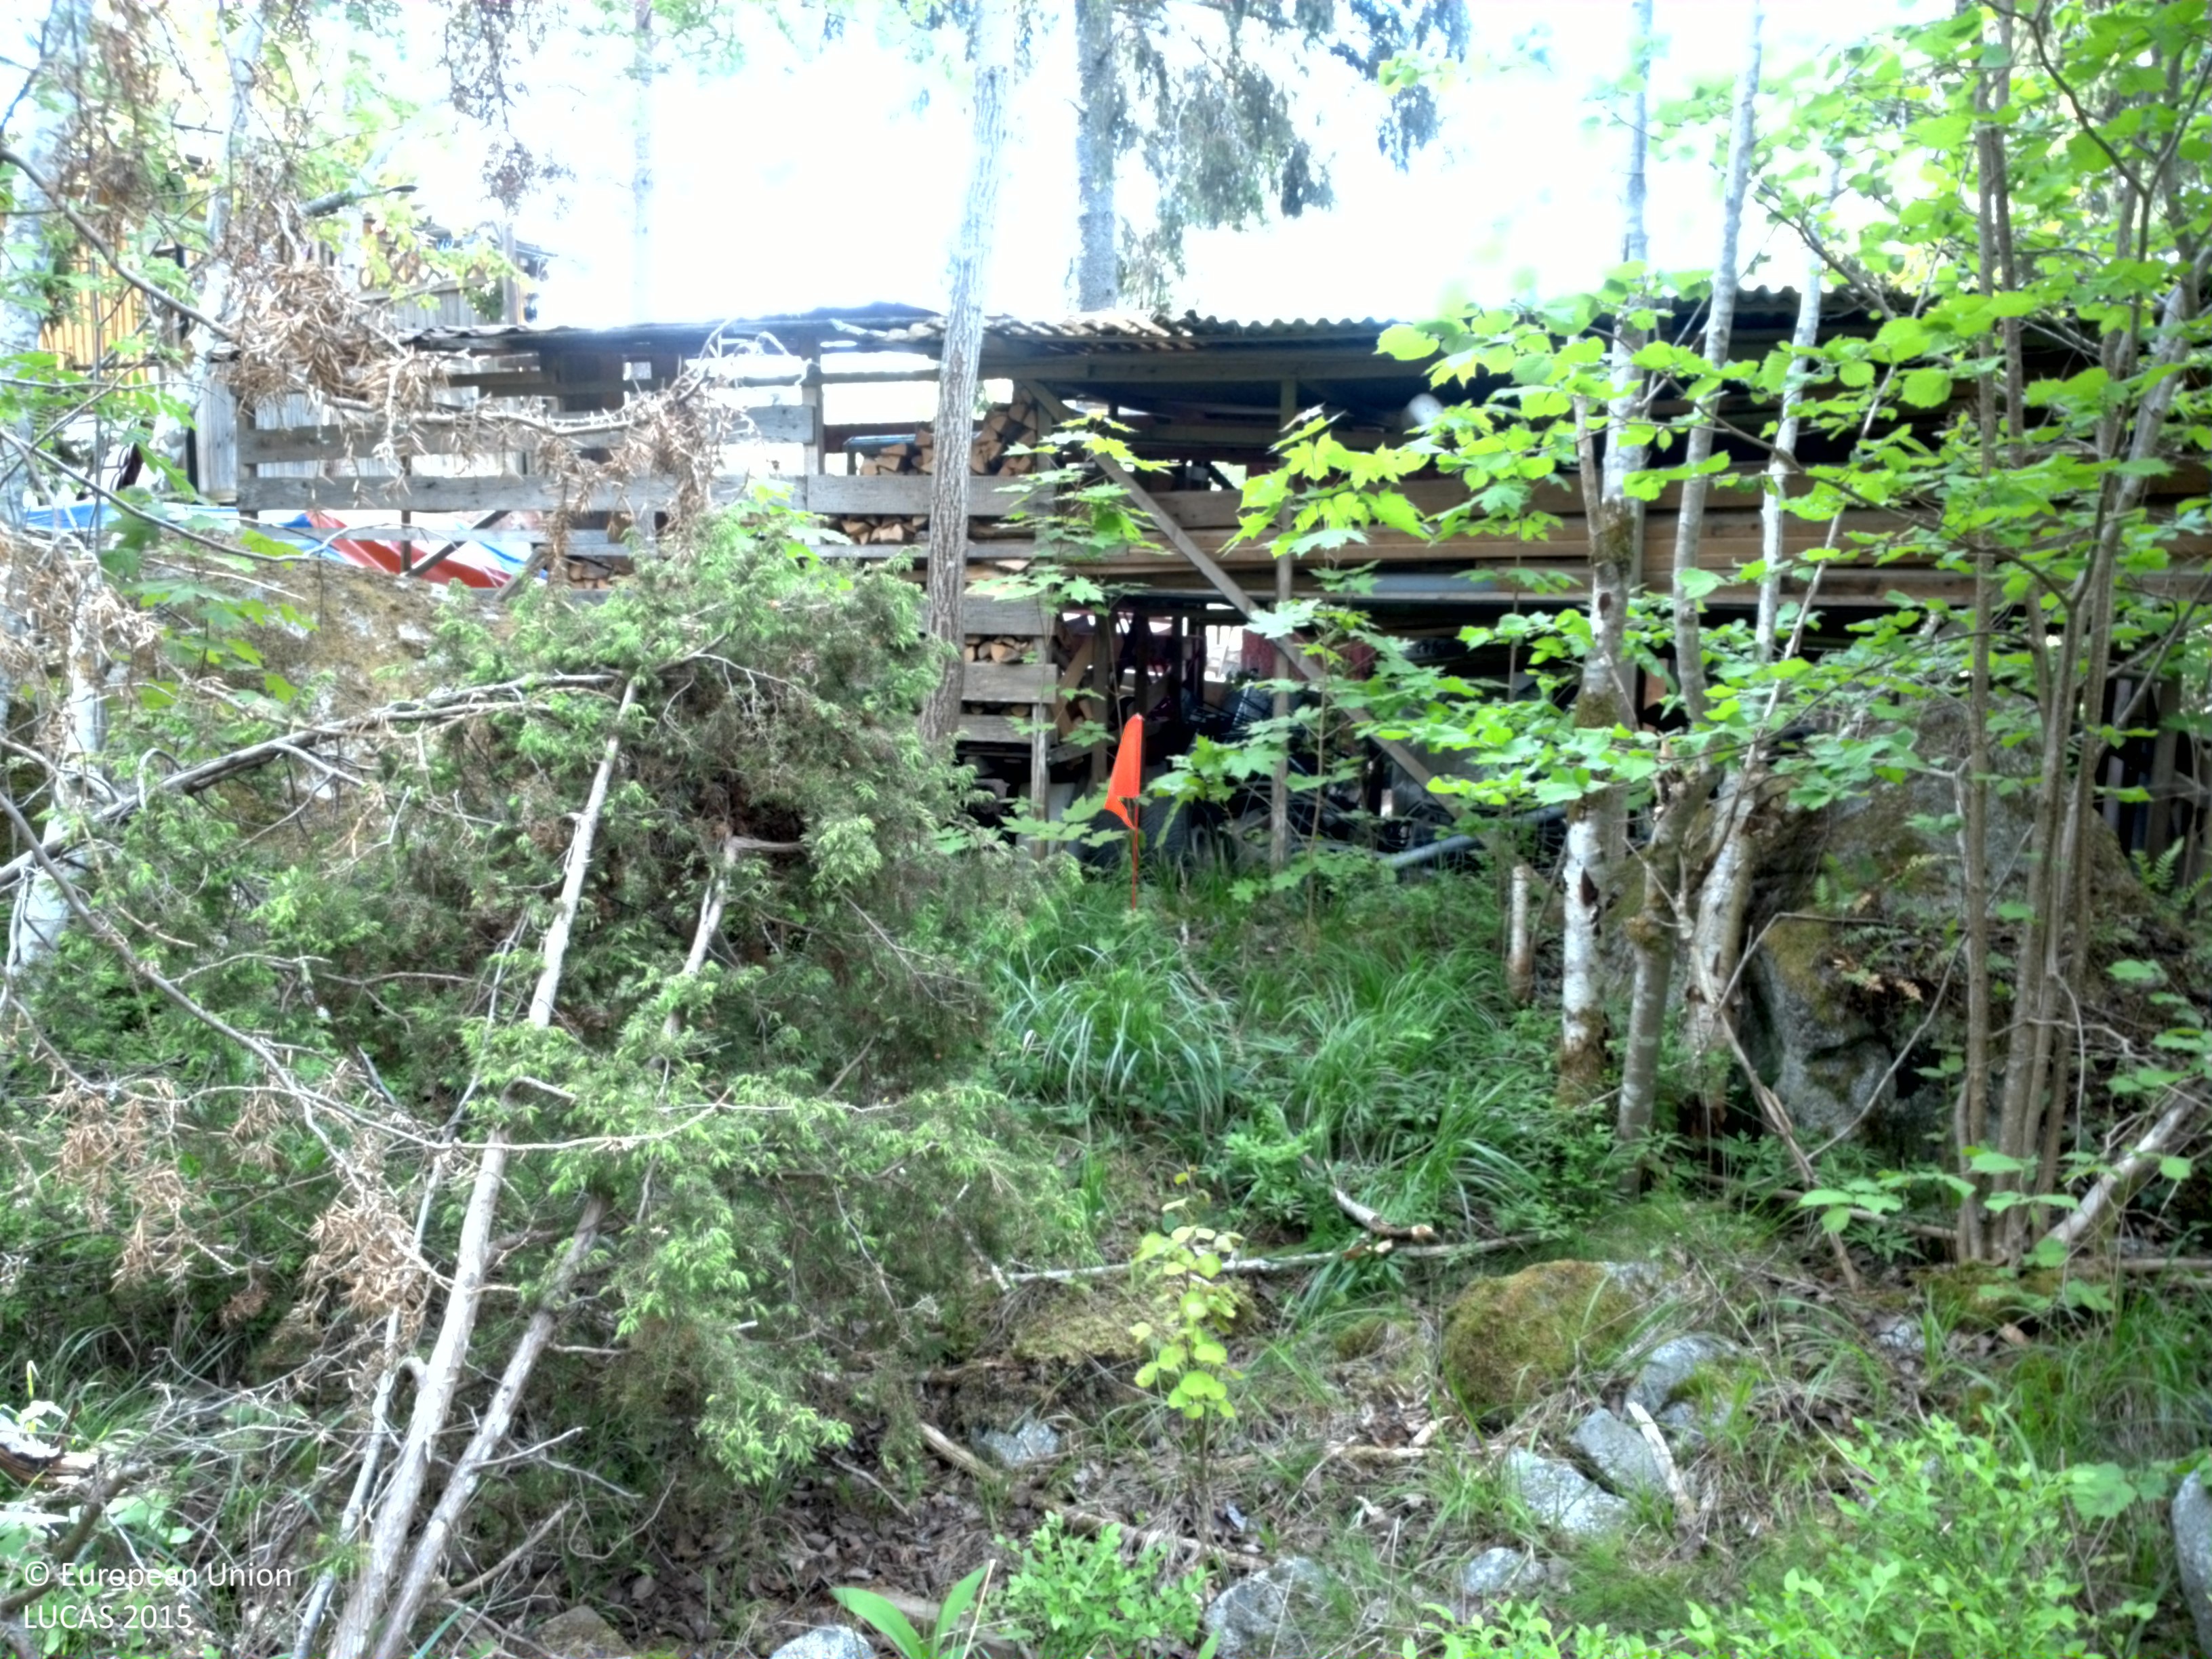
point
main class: Woodland
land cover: Spruce dominated mixed woodland
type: hemiboreal forest and nemoral coniferous forest and mixed broadleaved-coniferous forest
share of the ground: > 75 %
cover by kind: coniferous forest trees 50 %, broadleaved forest trees 30 %, shrubs 10 %, herbaceous plants 5 %, lichens and mosses 5 %
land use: Forestry
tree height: > 5 m
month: June
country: SE
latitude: 59.7574
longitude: 18.8475
